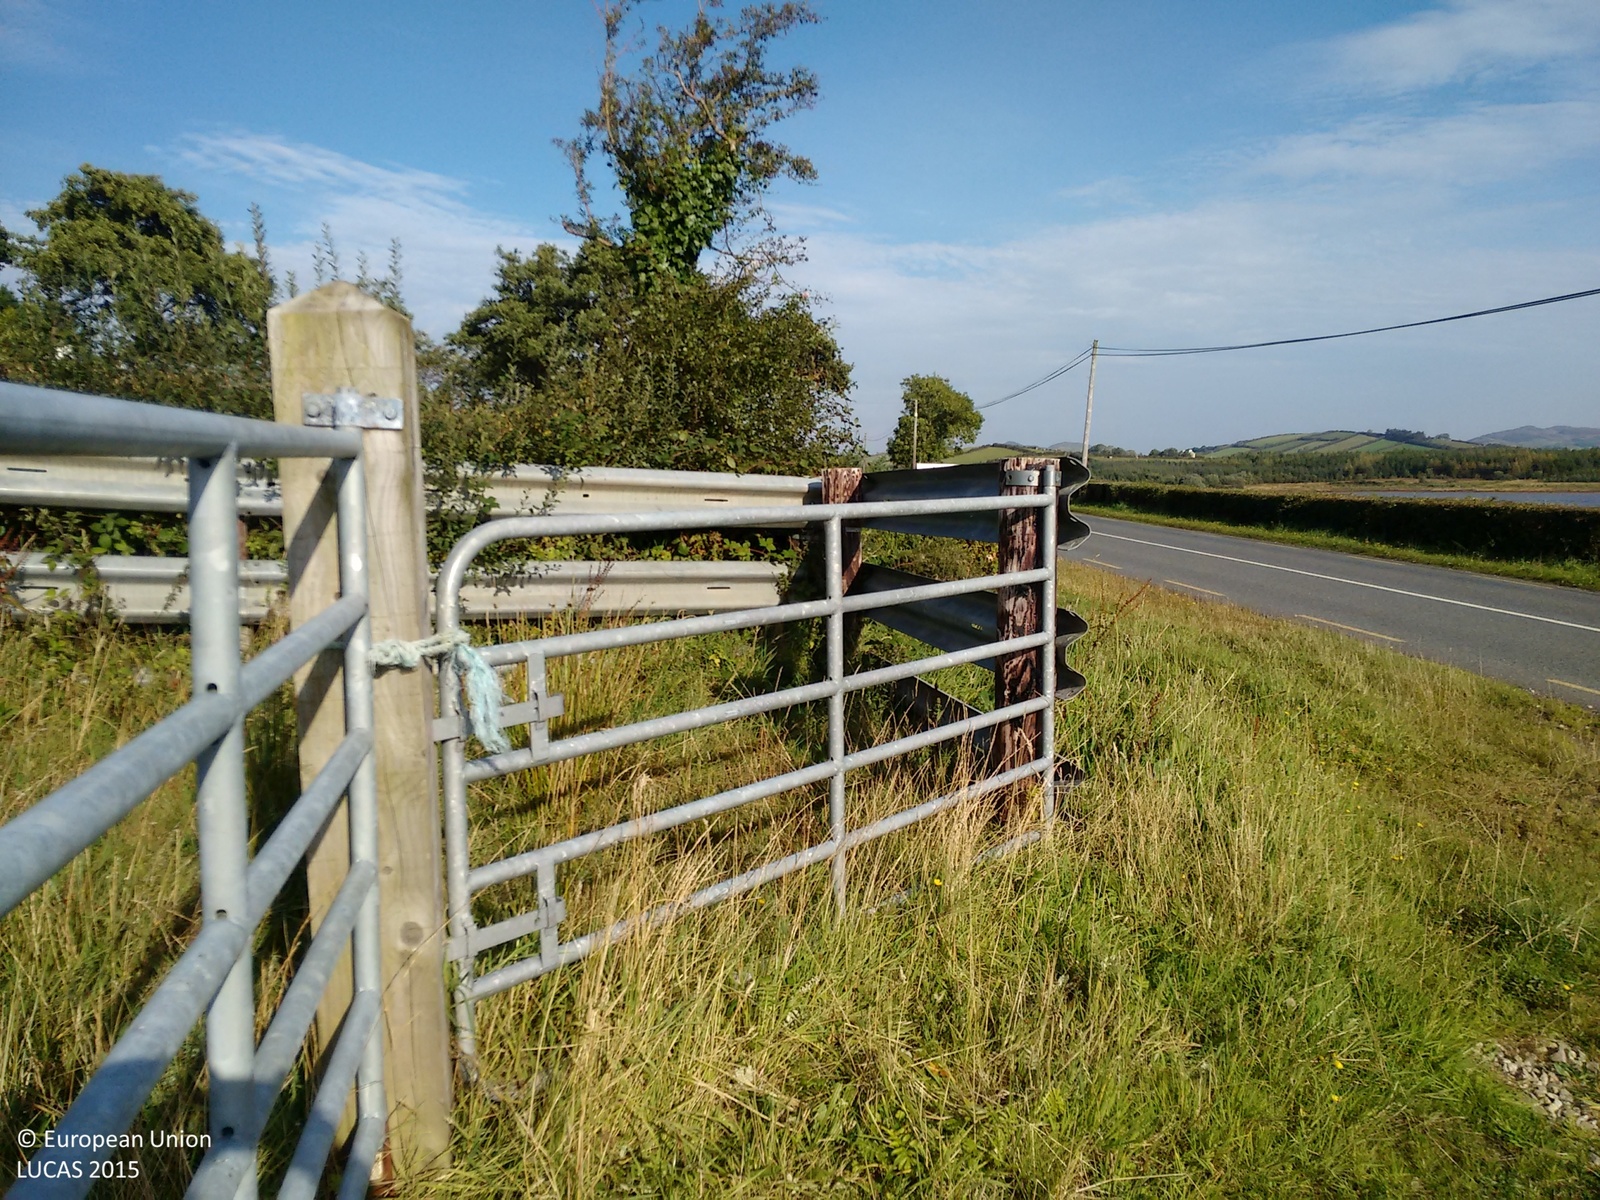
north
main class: Grassland
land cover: Grassland without tree/shrub cover
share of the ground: > 75 %
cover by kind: herbaceous plants 100 %
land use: Agriculture (excluding fallow land and kitchen gardens)
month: September
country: IE
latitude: 55.1598
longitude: -7.7243
